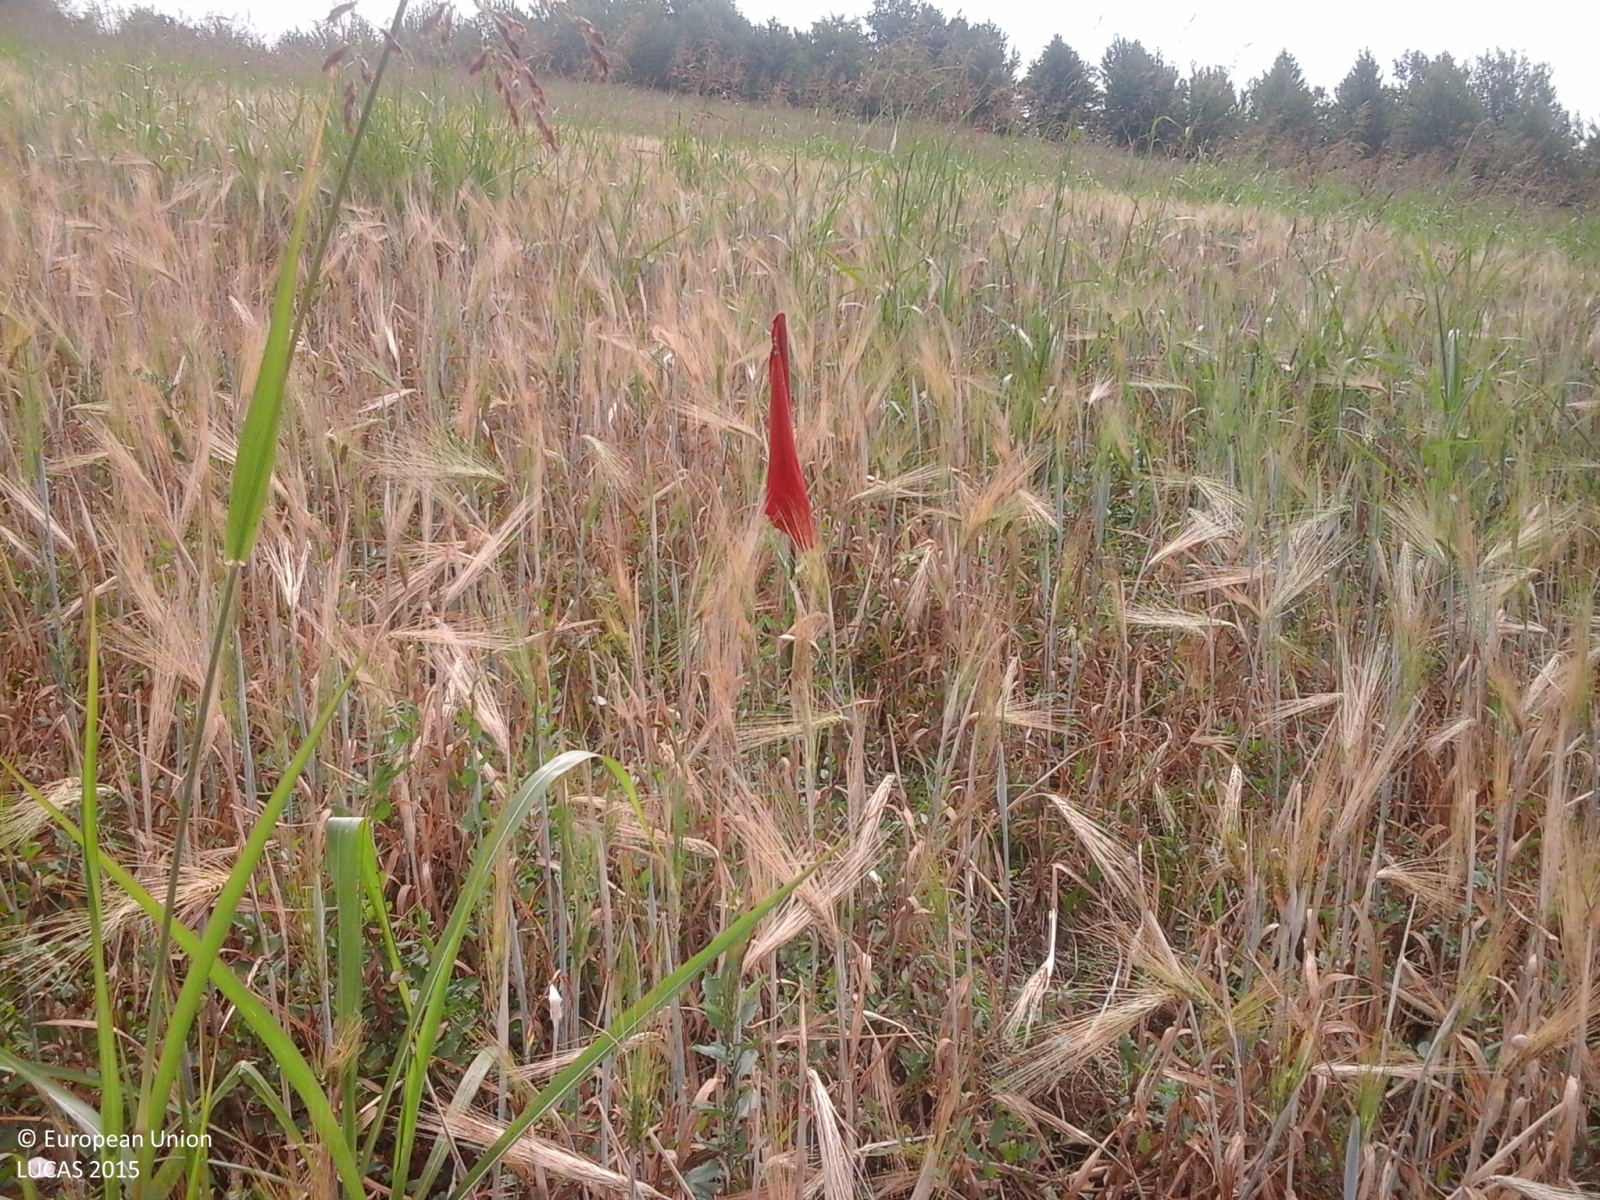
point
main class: Cropland
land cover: Barley
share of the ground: > 75 %
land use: Agriculture (excluding fallow land and kitchen gardens)
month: June
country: IT
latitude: 44.9723
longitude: 8.5952
